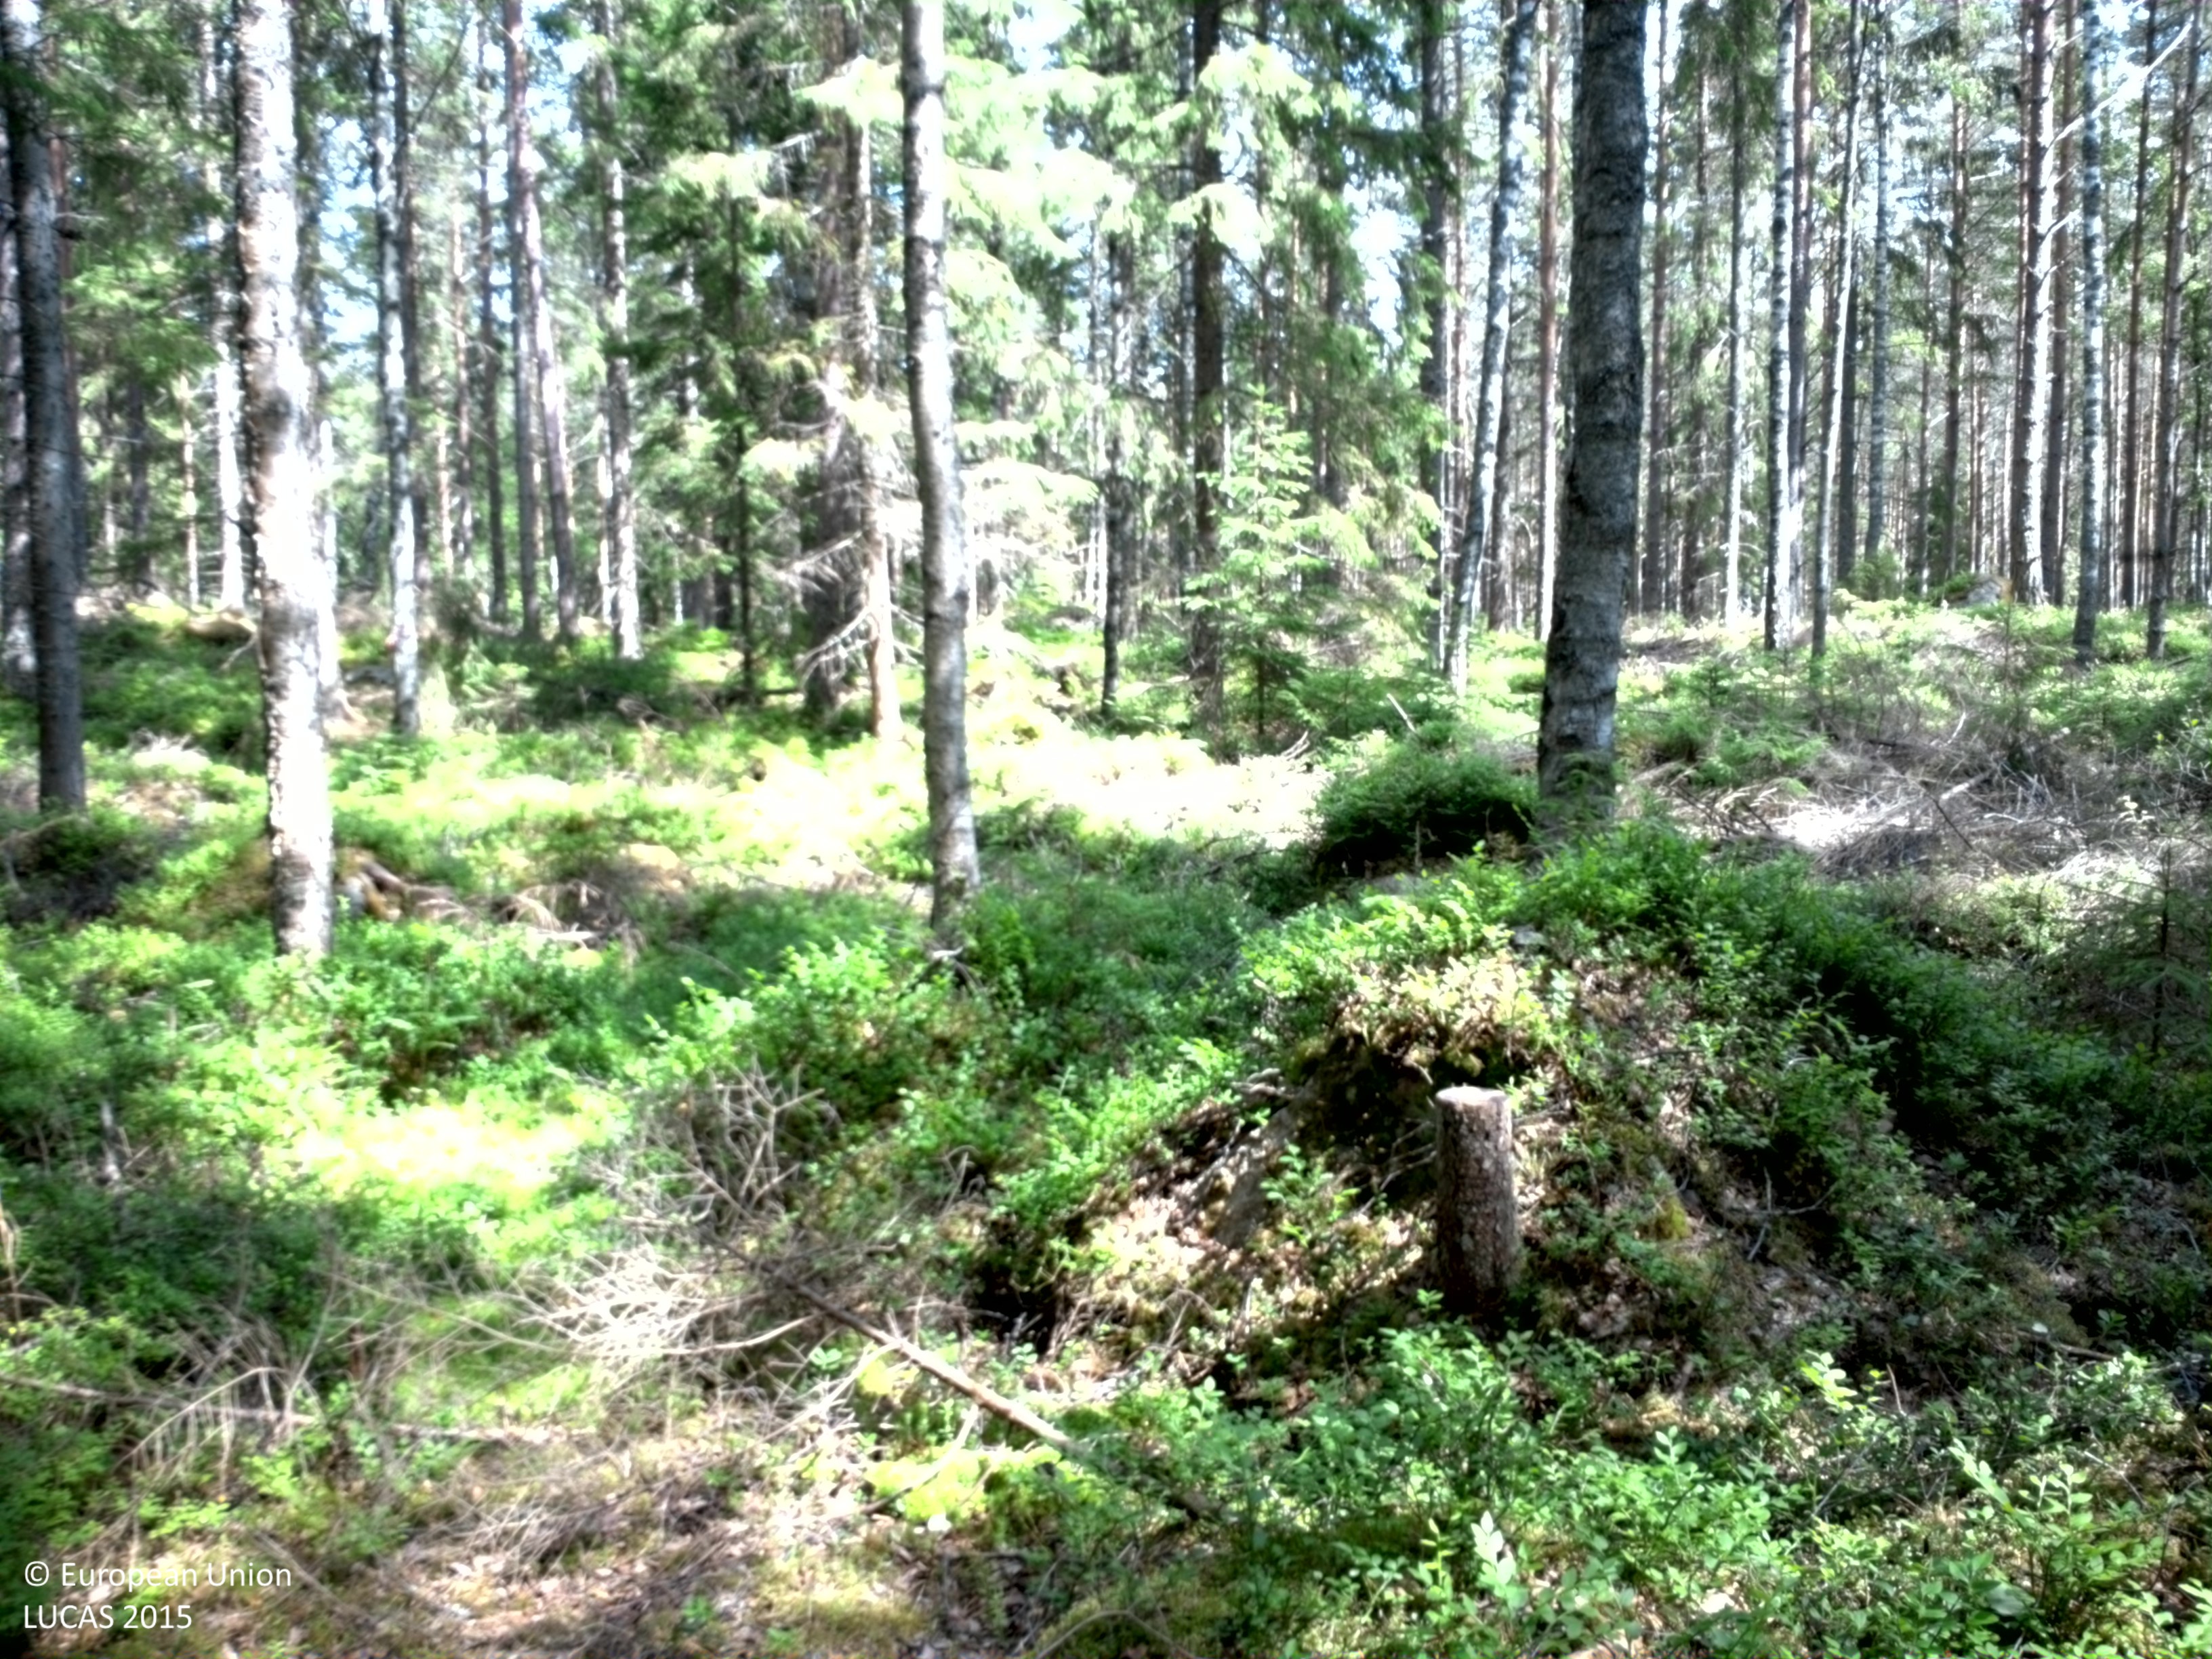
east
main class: Woodland
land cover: Spruce dominated mixed woodland
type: boreal forest
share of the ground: 25 - 50 %
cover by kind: herbaceous plants 35 %, coniferous forest trees 30 %, lichens and mosses 20 %, broadleaved forest trees 15 %
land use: Forestry
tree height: > 5 m
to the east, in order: Spruce dominated mixed woodland; Pine dominated mixed woodland; Pine dominated coniferous woodland; Spruce dominated coniferous woodland
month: July
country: SE
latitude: 58.8465
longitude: 14.5159
